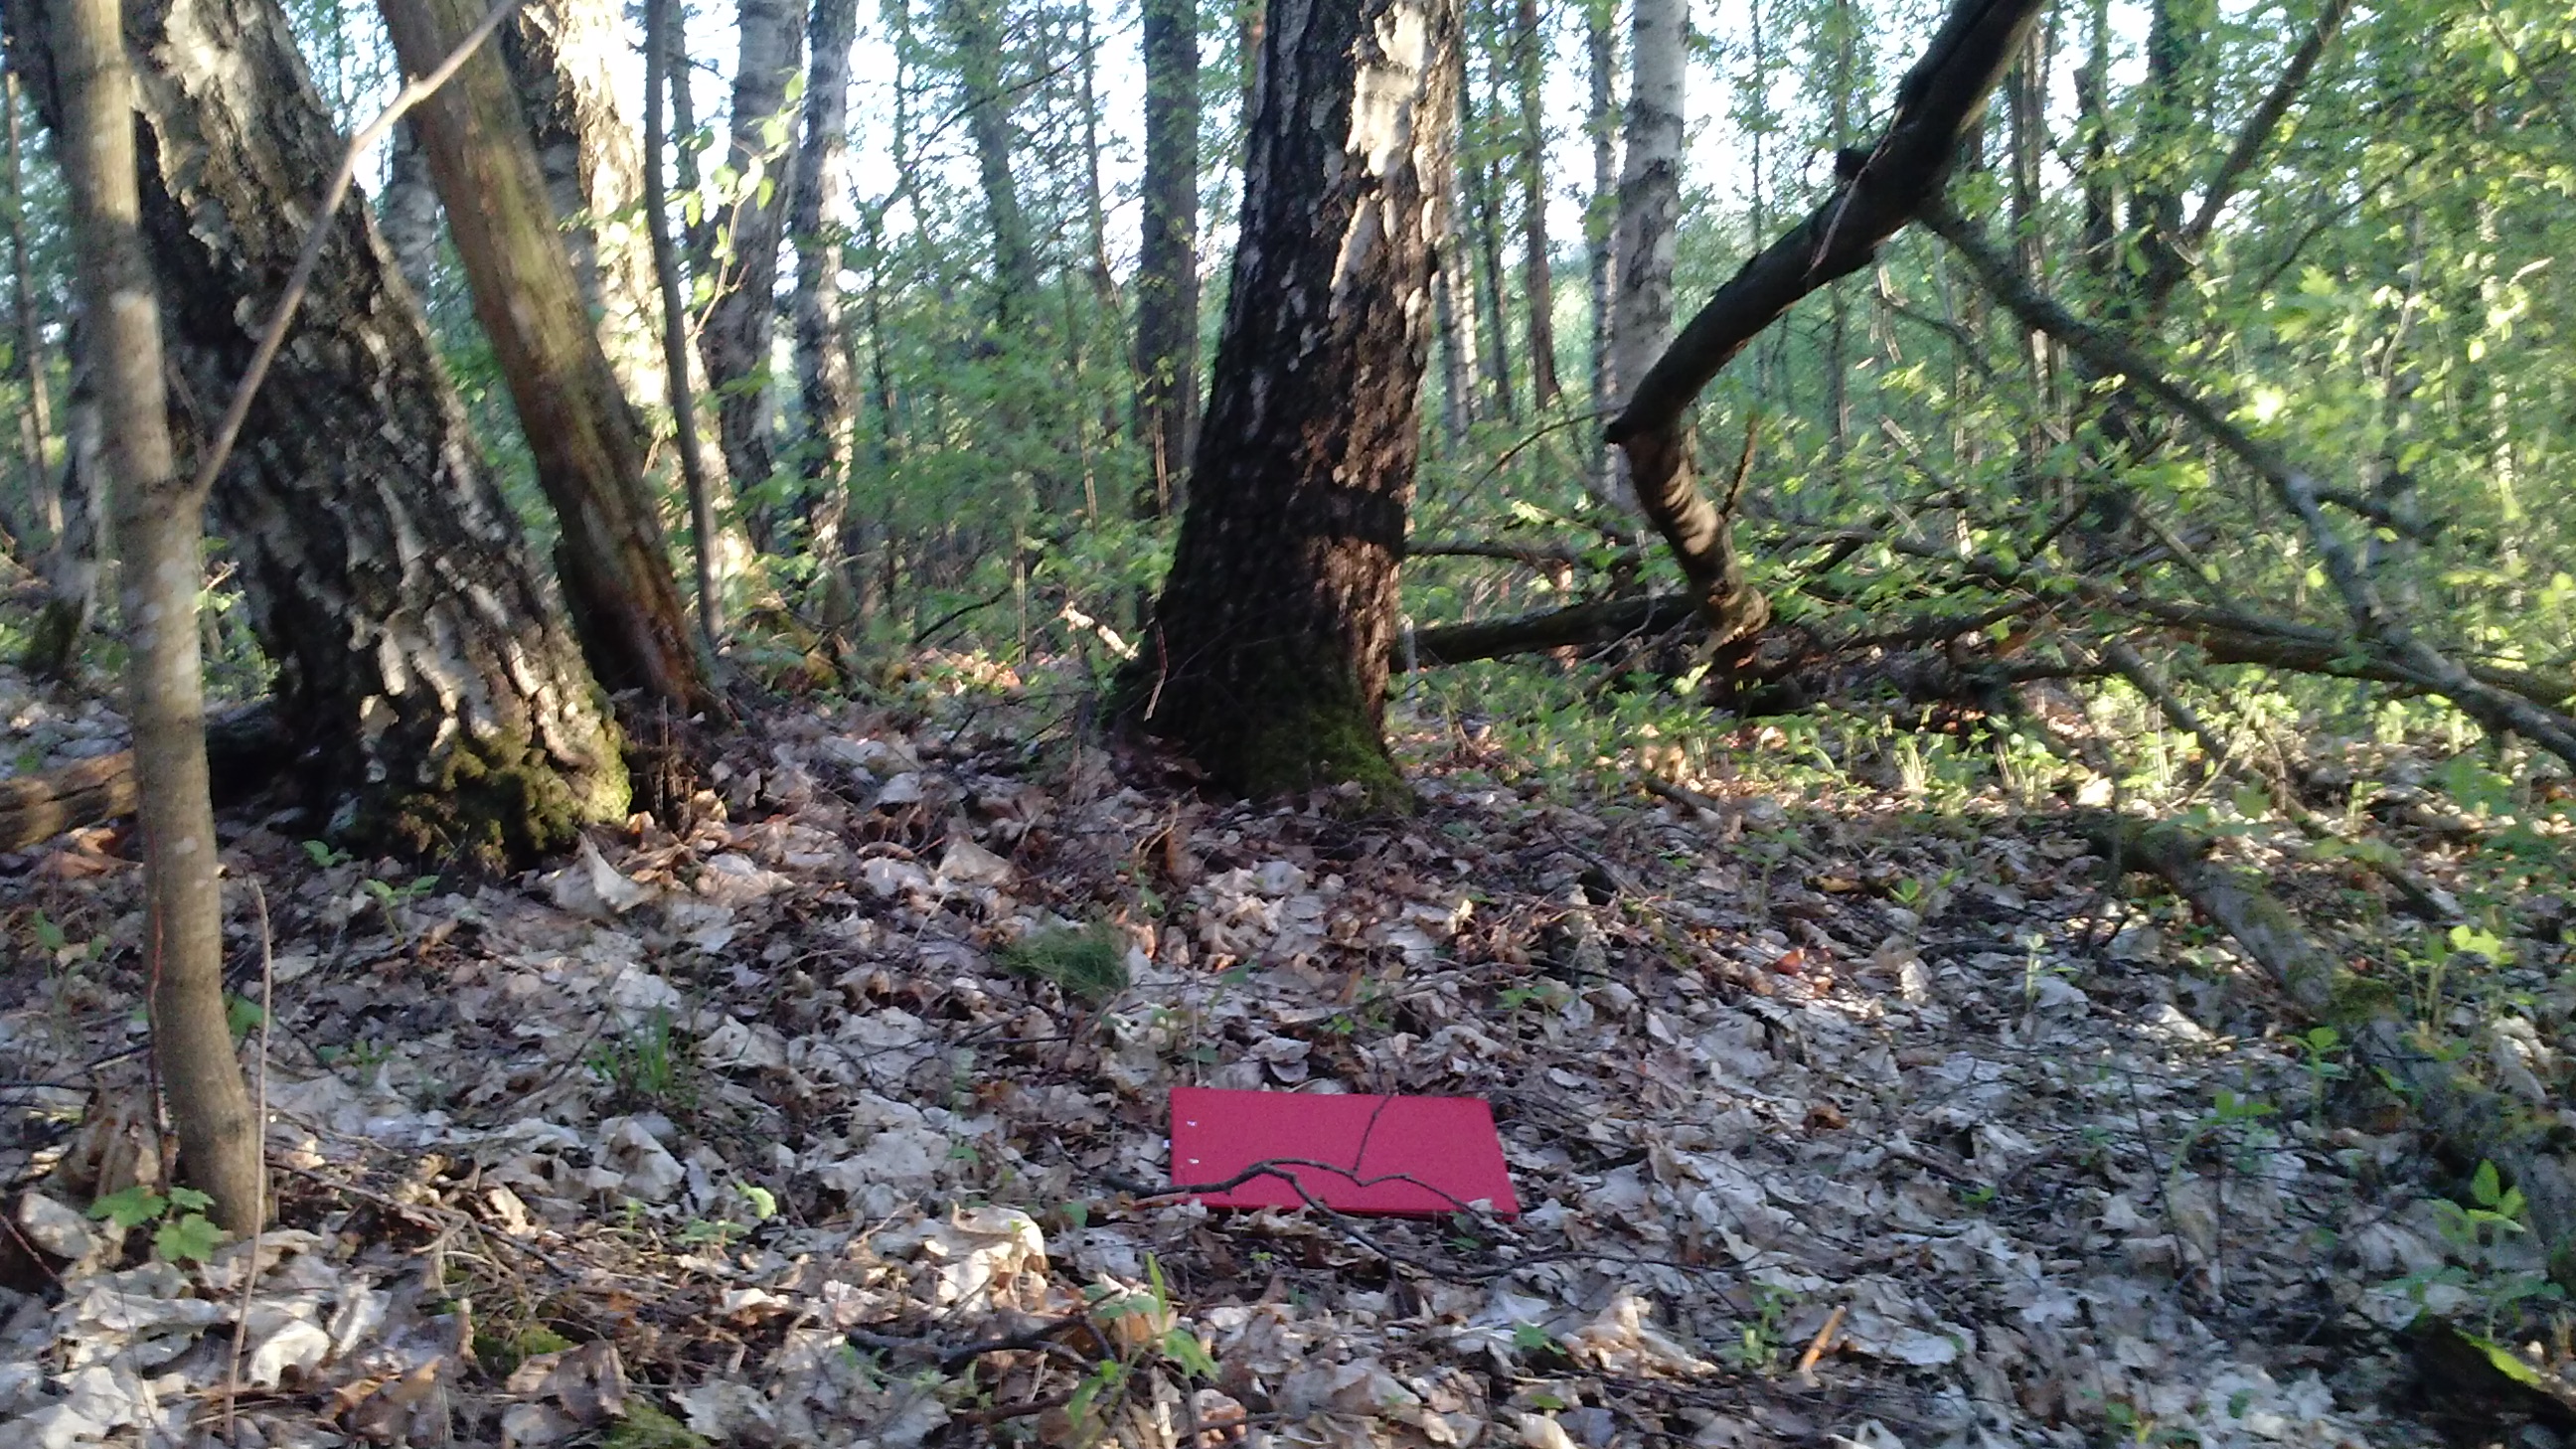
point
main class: Woodland
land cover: Broadleaved woodland
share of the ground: > 75 %
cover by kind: broadleaved forest trees 100 %
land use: Forestry
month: May
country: LV
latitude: 56.0795
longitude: 27.2200
